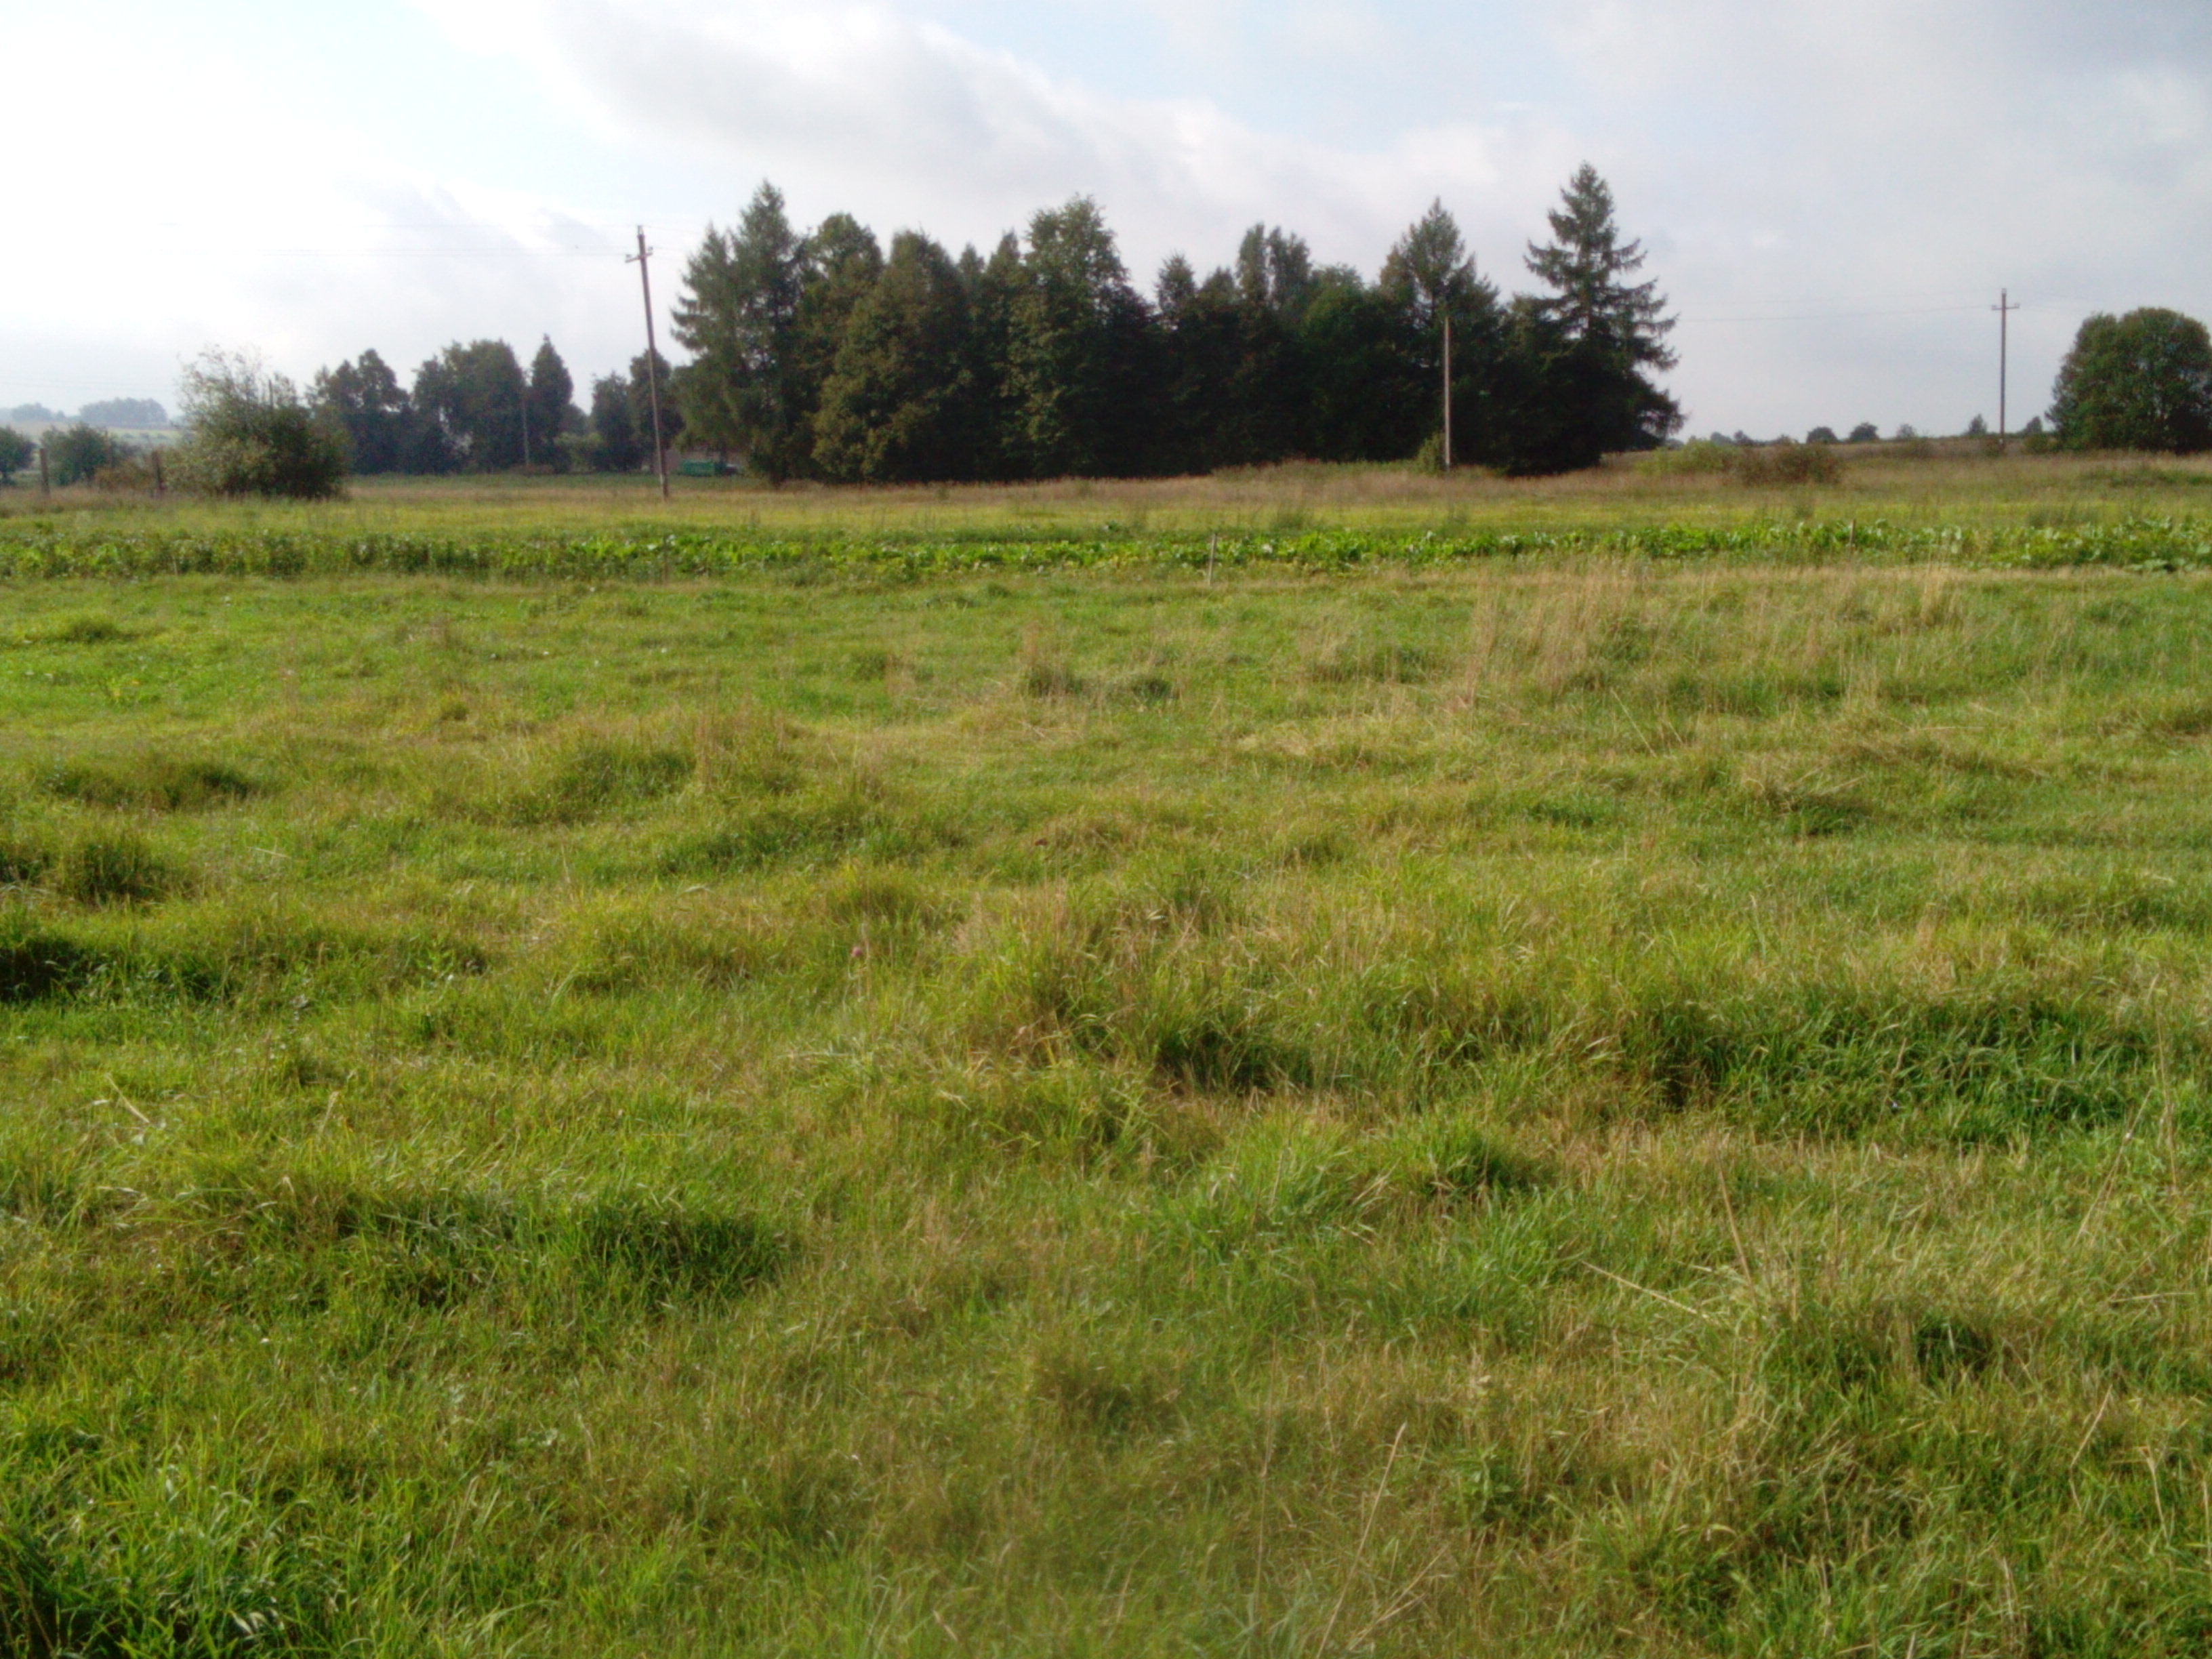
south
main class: Grassland
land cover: Grassland without tree/shrub cover
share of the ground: > 75 %
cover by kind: herbaceous plants 100 %
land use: Agriculture (excluding fallow land and kitchen gardens)
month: September
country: LT
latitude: 55.8296
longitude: 22.8534
